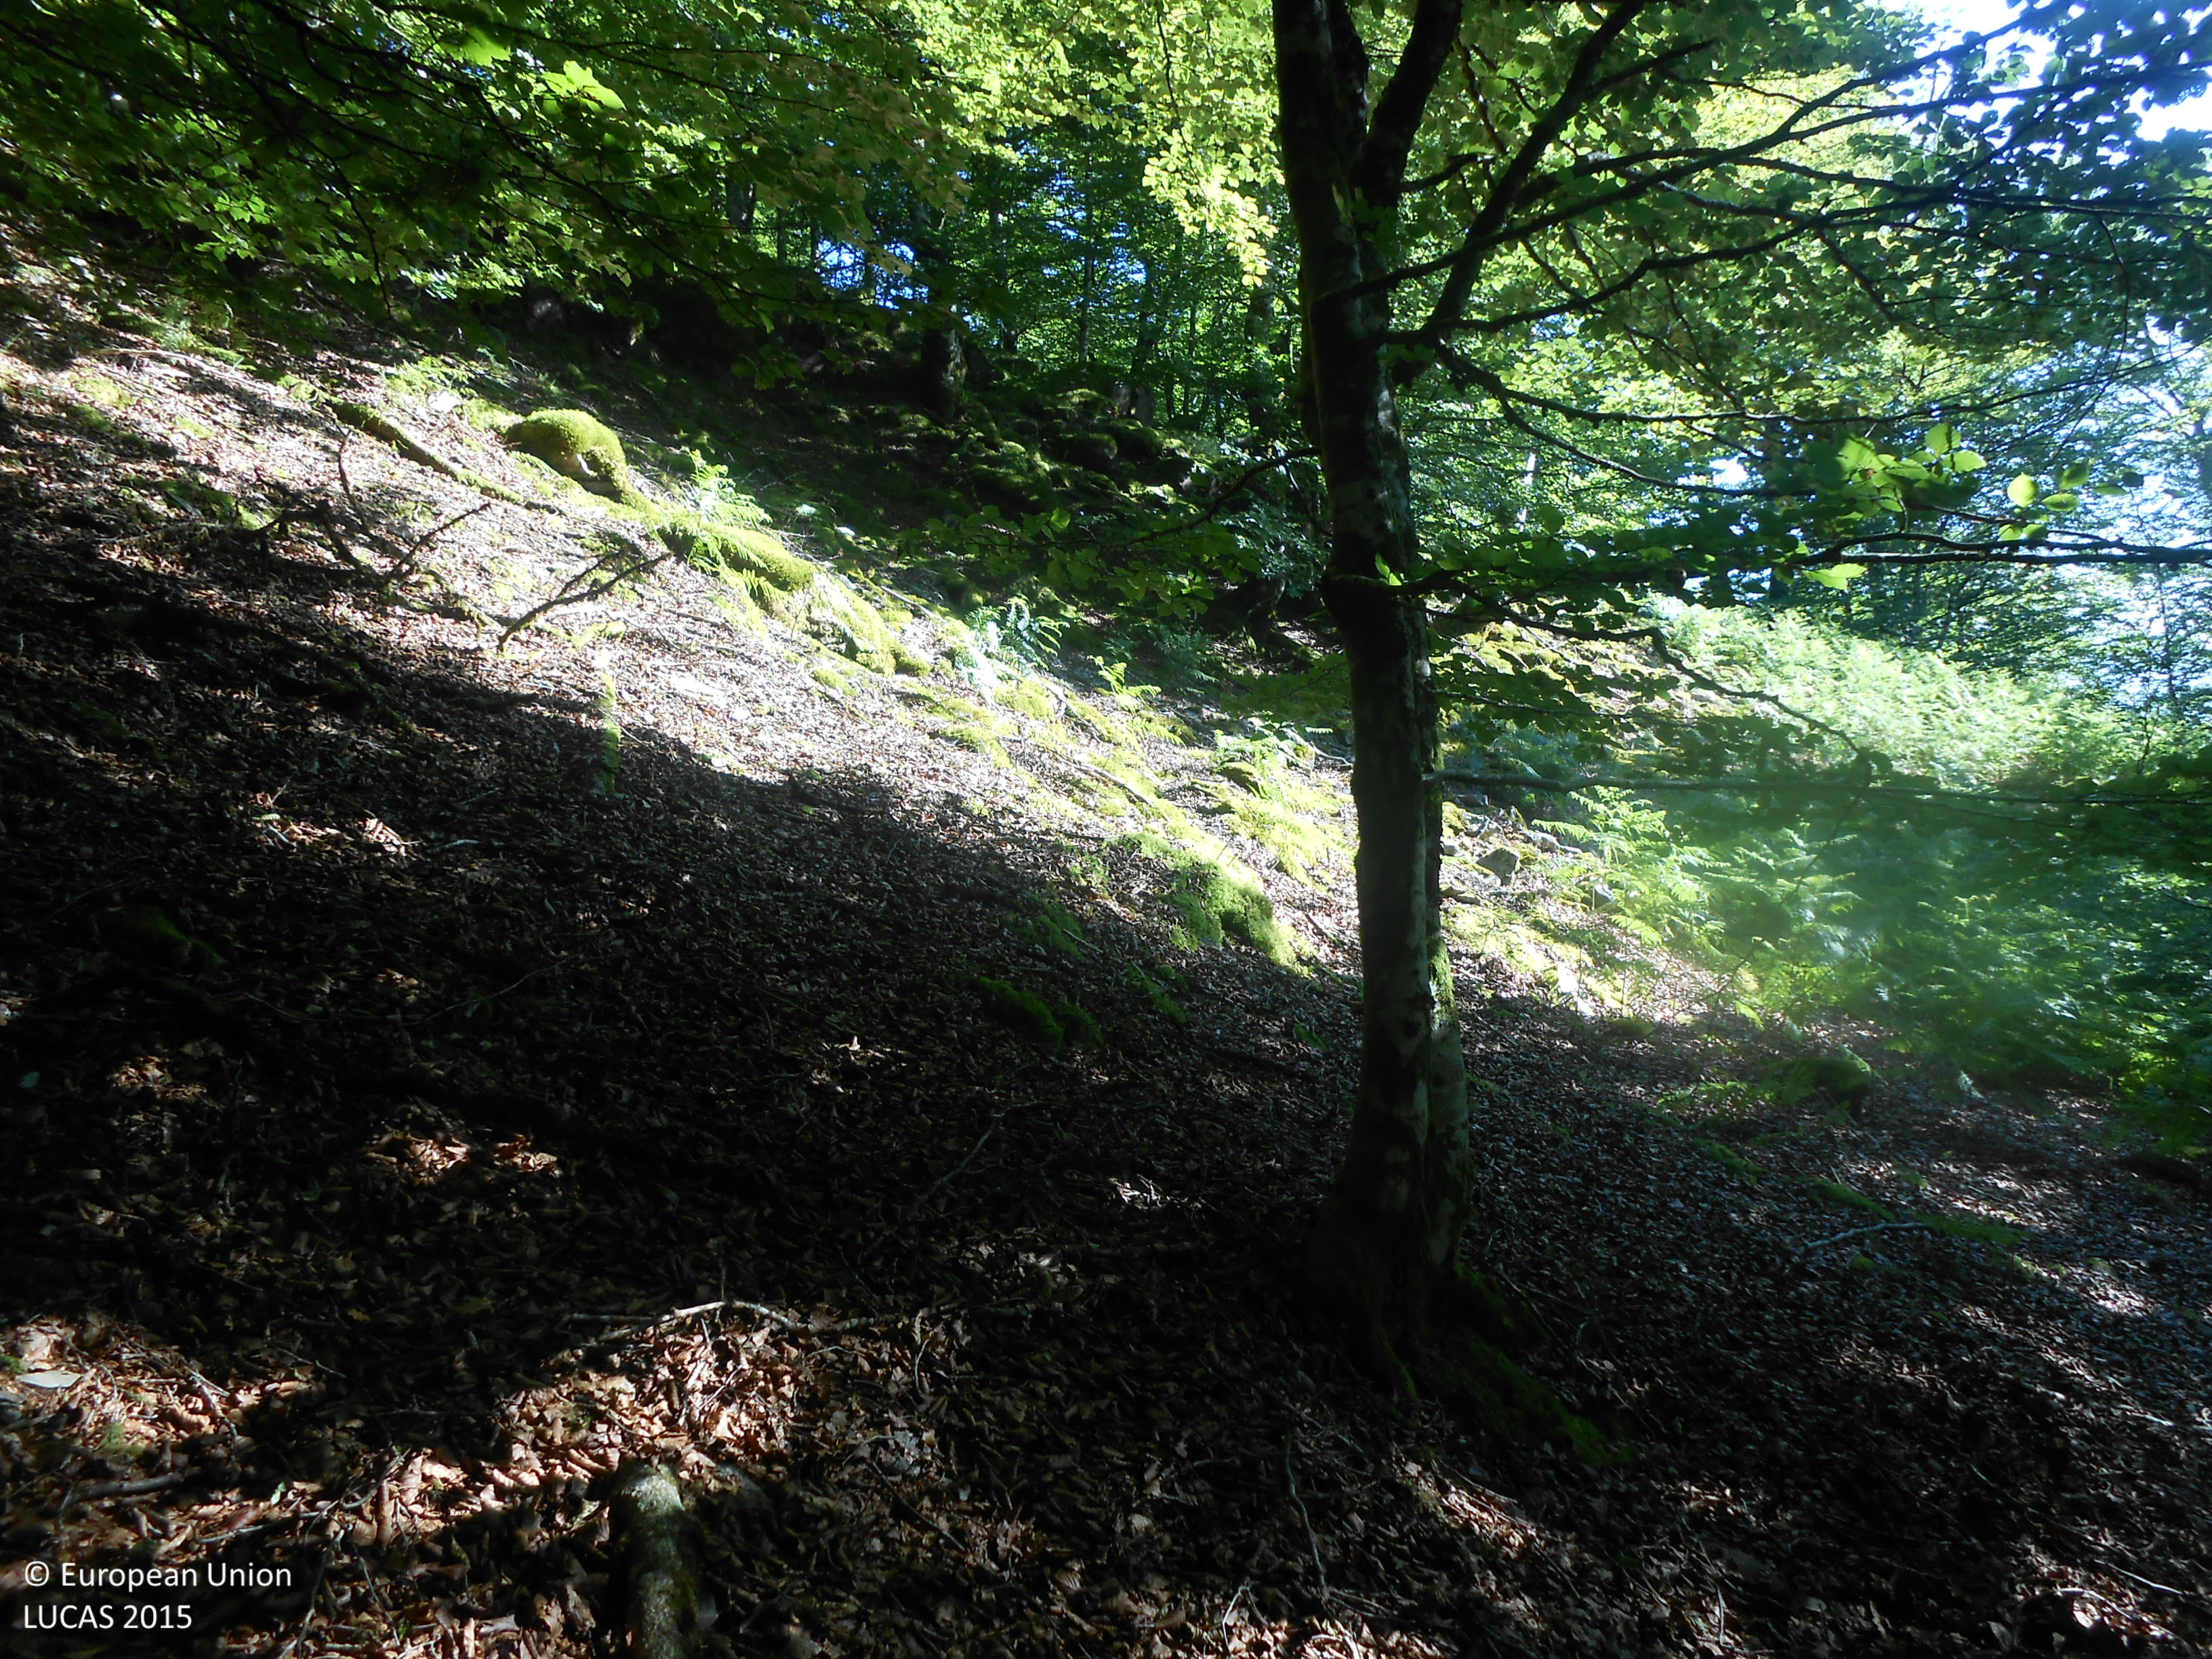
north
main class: Woodland
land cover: Broadleaved woodland
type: beech forest
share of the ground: > 75 %
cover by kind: broadleaved forest trees 100 %
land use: Forestry
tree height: > 5 m
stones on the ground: 25 - 50 %
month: June
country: ES
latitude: 43.1125
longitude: -1.7793
